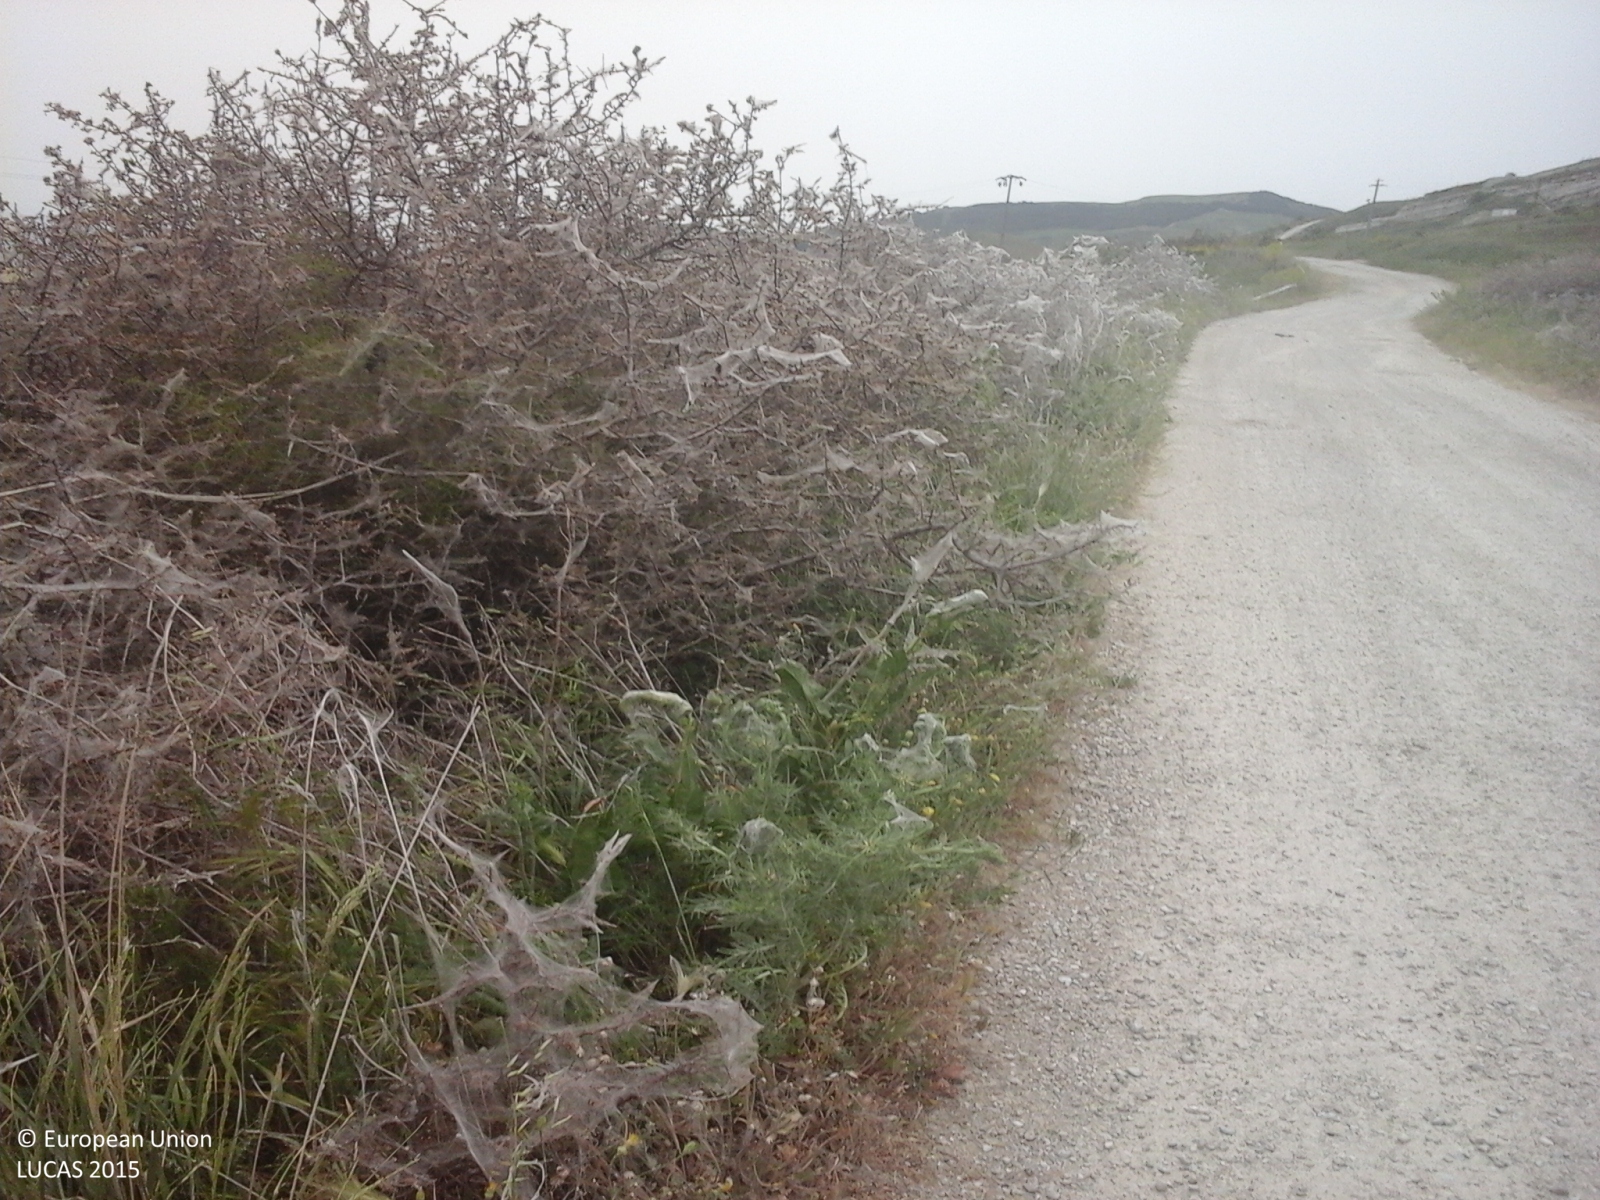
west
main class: Cropland
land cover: Durum wheat
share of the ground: > 75 %
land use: Agriculture (excluding fallow land and kitchen gardens)
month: May
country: IT
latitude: 37.7177
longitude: 13.5474
